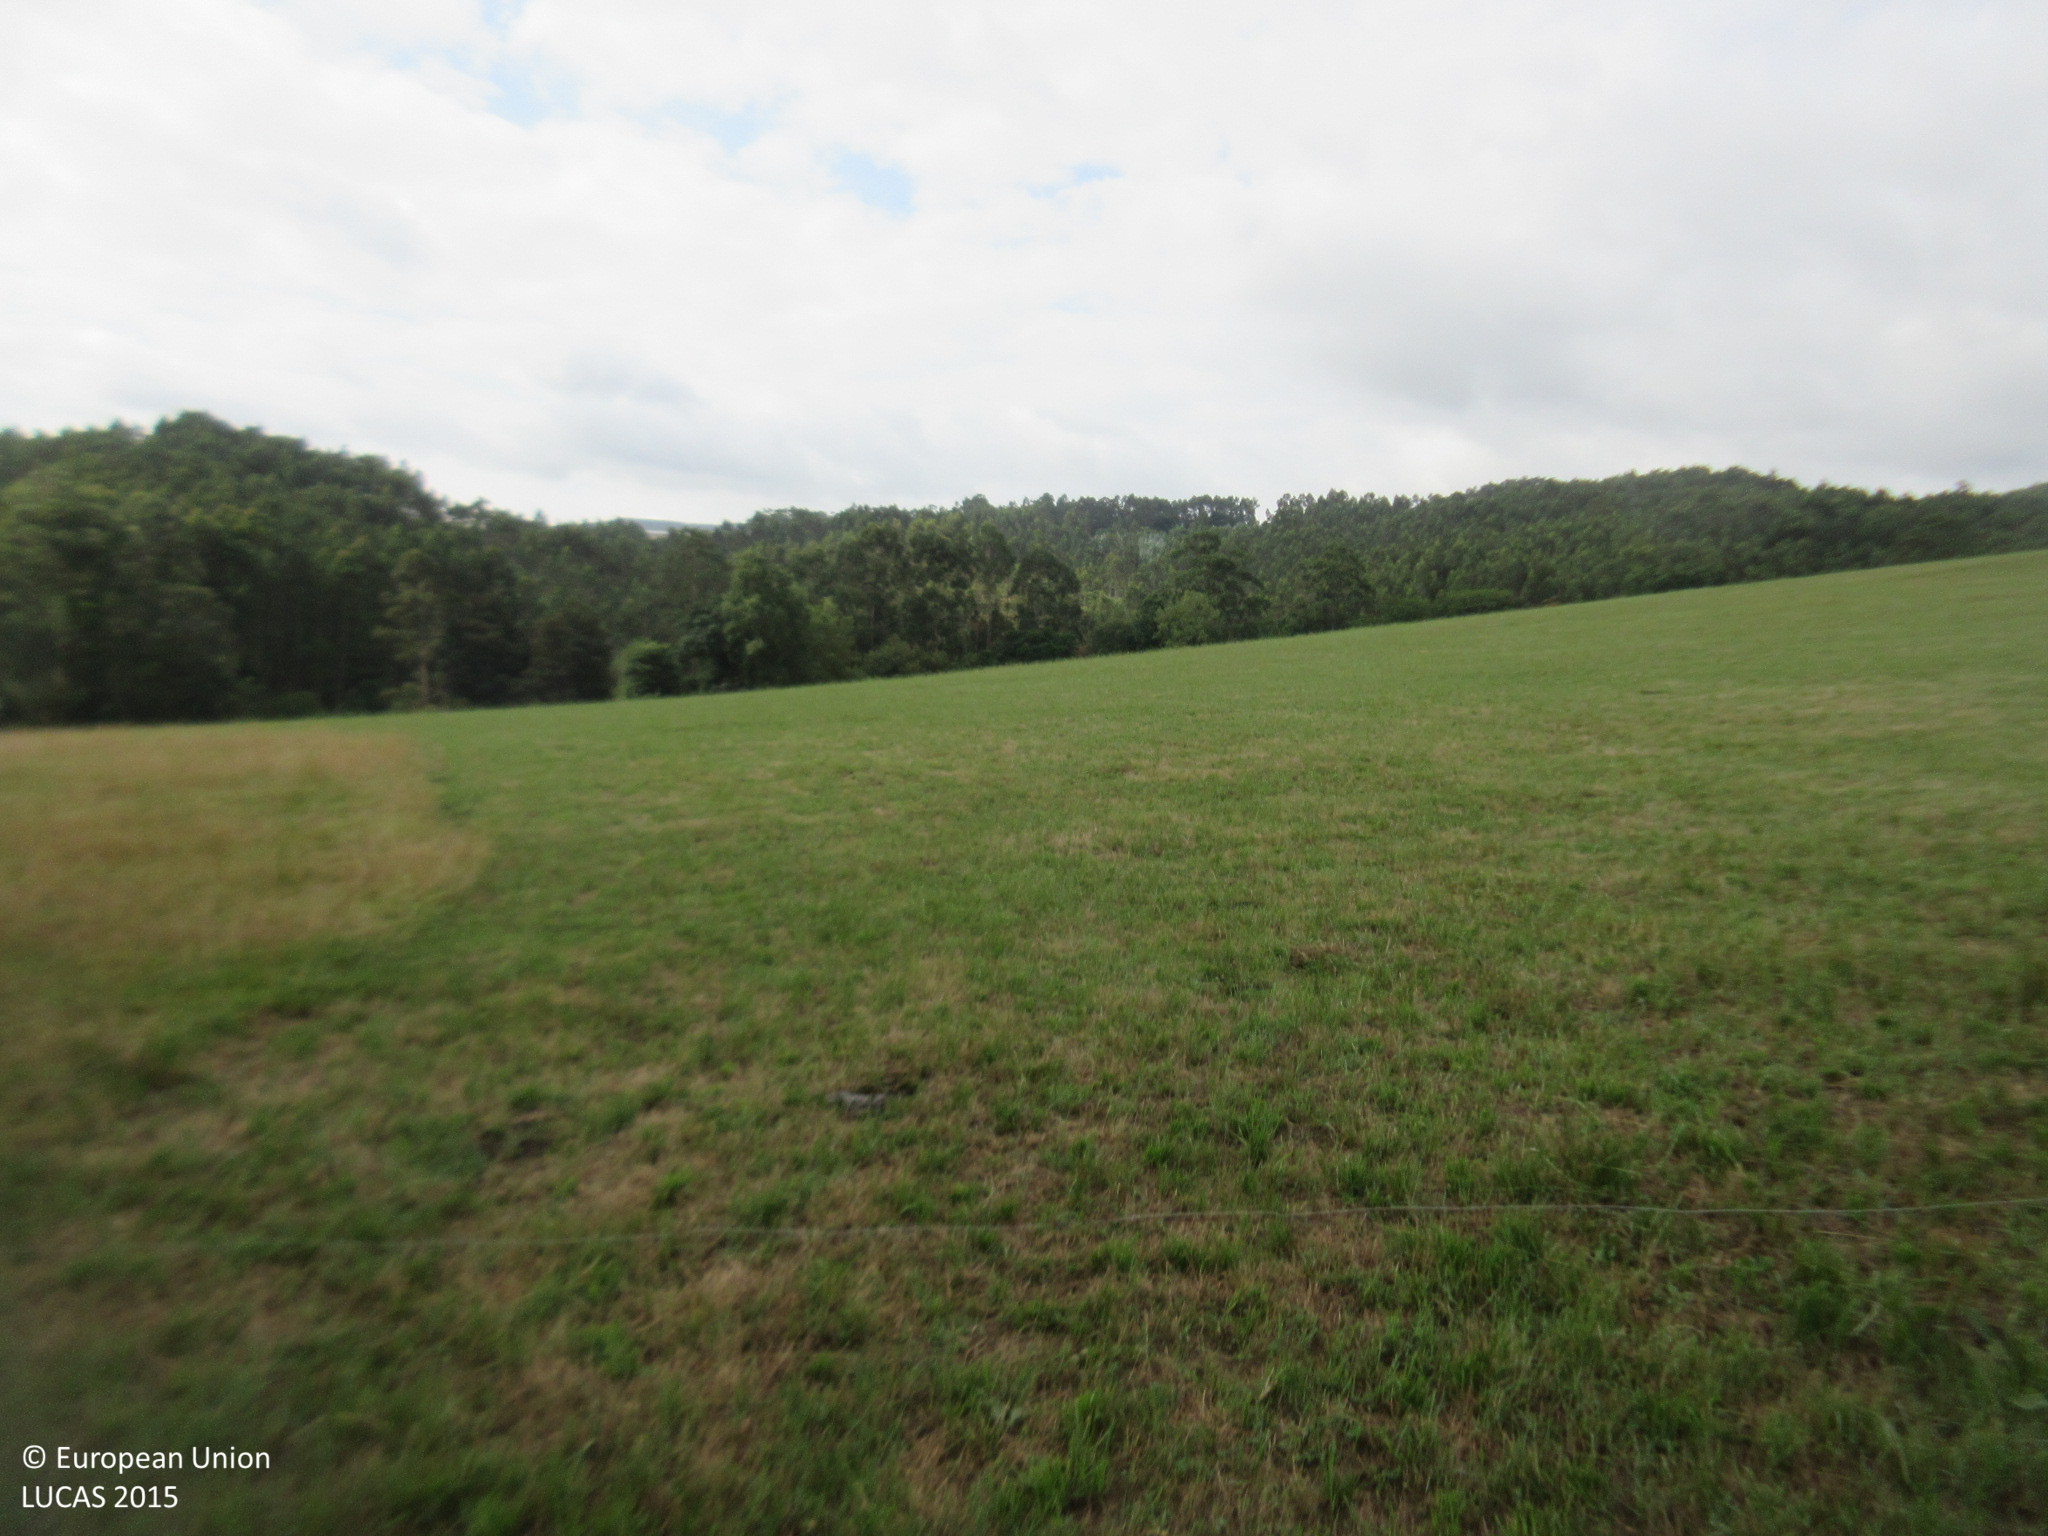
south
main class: Cropland
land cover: Temporary grasslands
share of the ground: > 75 %
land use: Agriculture (excluding fallow land and kitchen gardens)
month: July
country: ES
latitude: 43.3409
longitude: -4.0023
